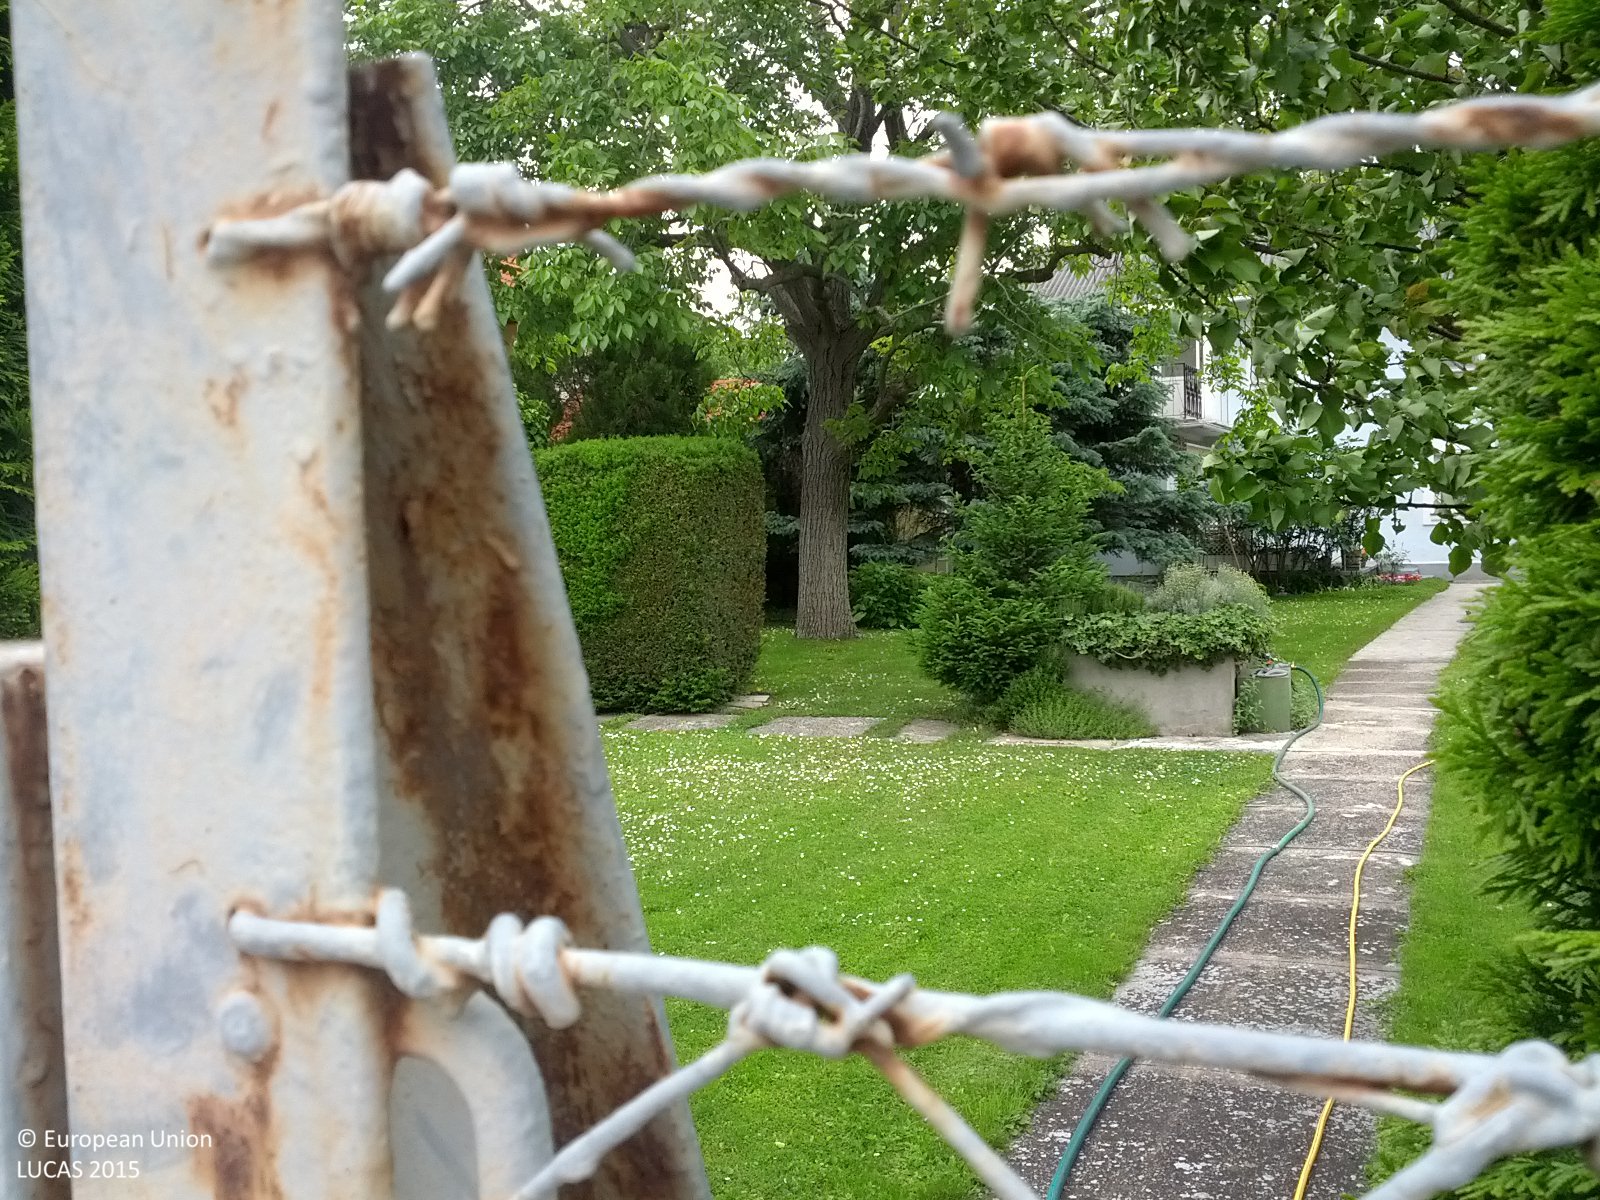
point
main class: Cropland
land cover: Nuts trees
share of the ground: 25 - 50 %
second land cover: Grassland without tree/shrub cover
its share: 50 - 75 %
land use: Kitchen garden
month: May
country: AT
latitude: 48.2282
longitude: 16.5347
